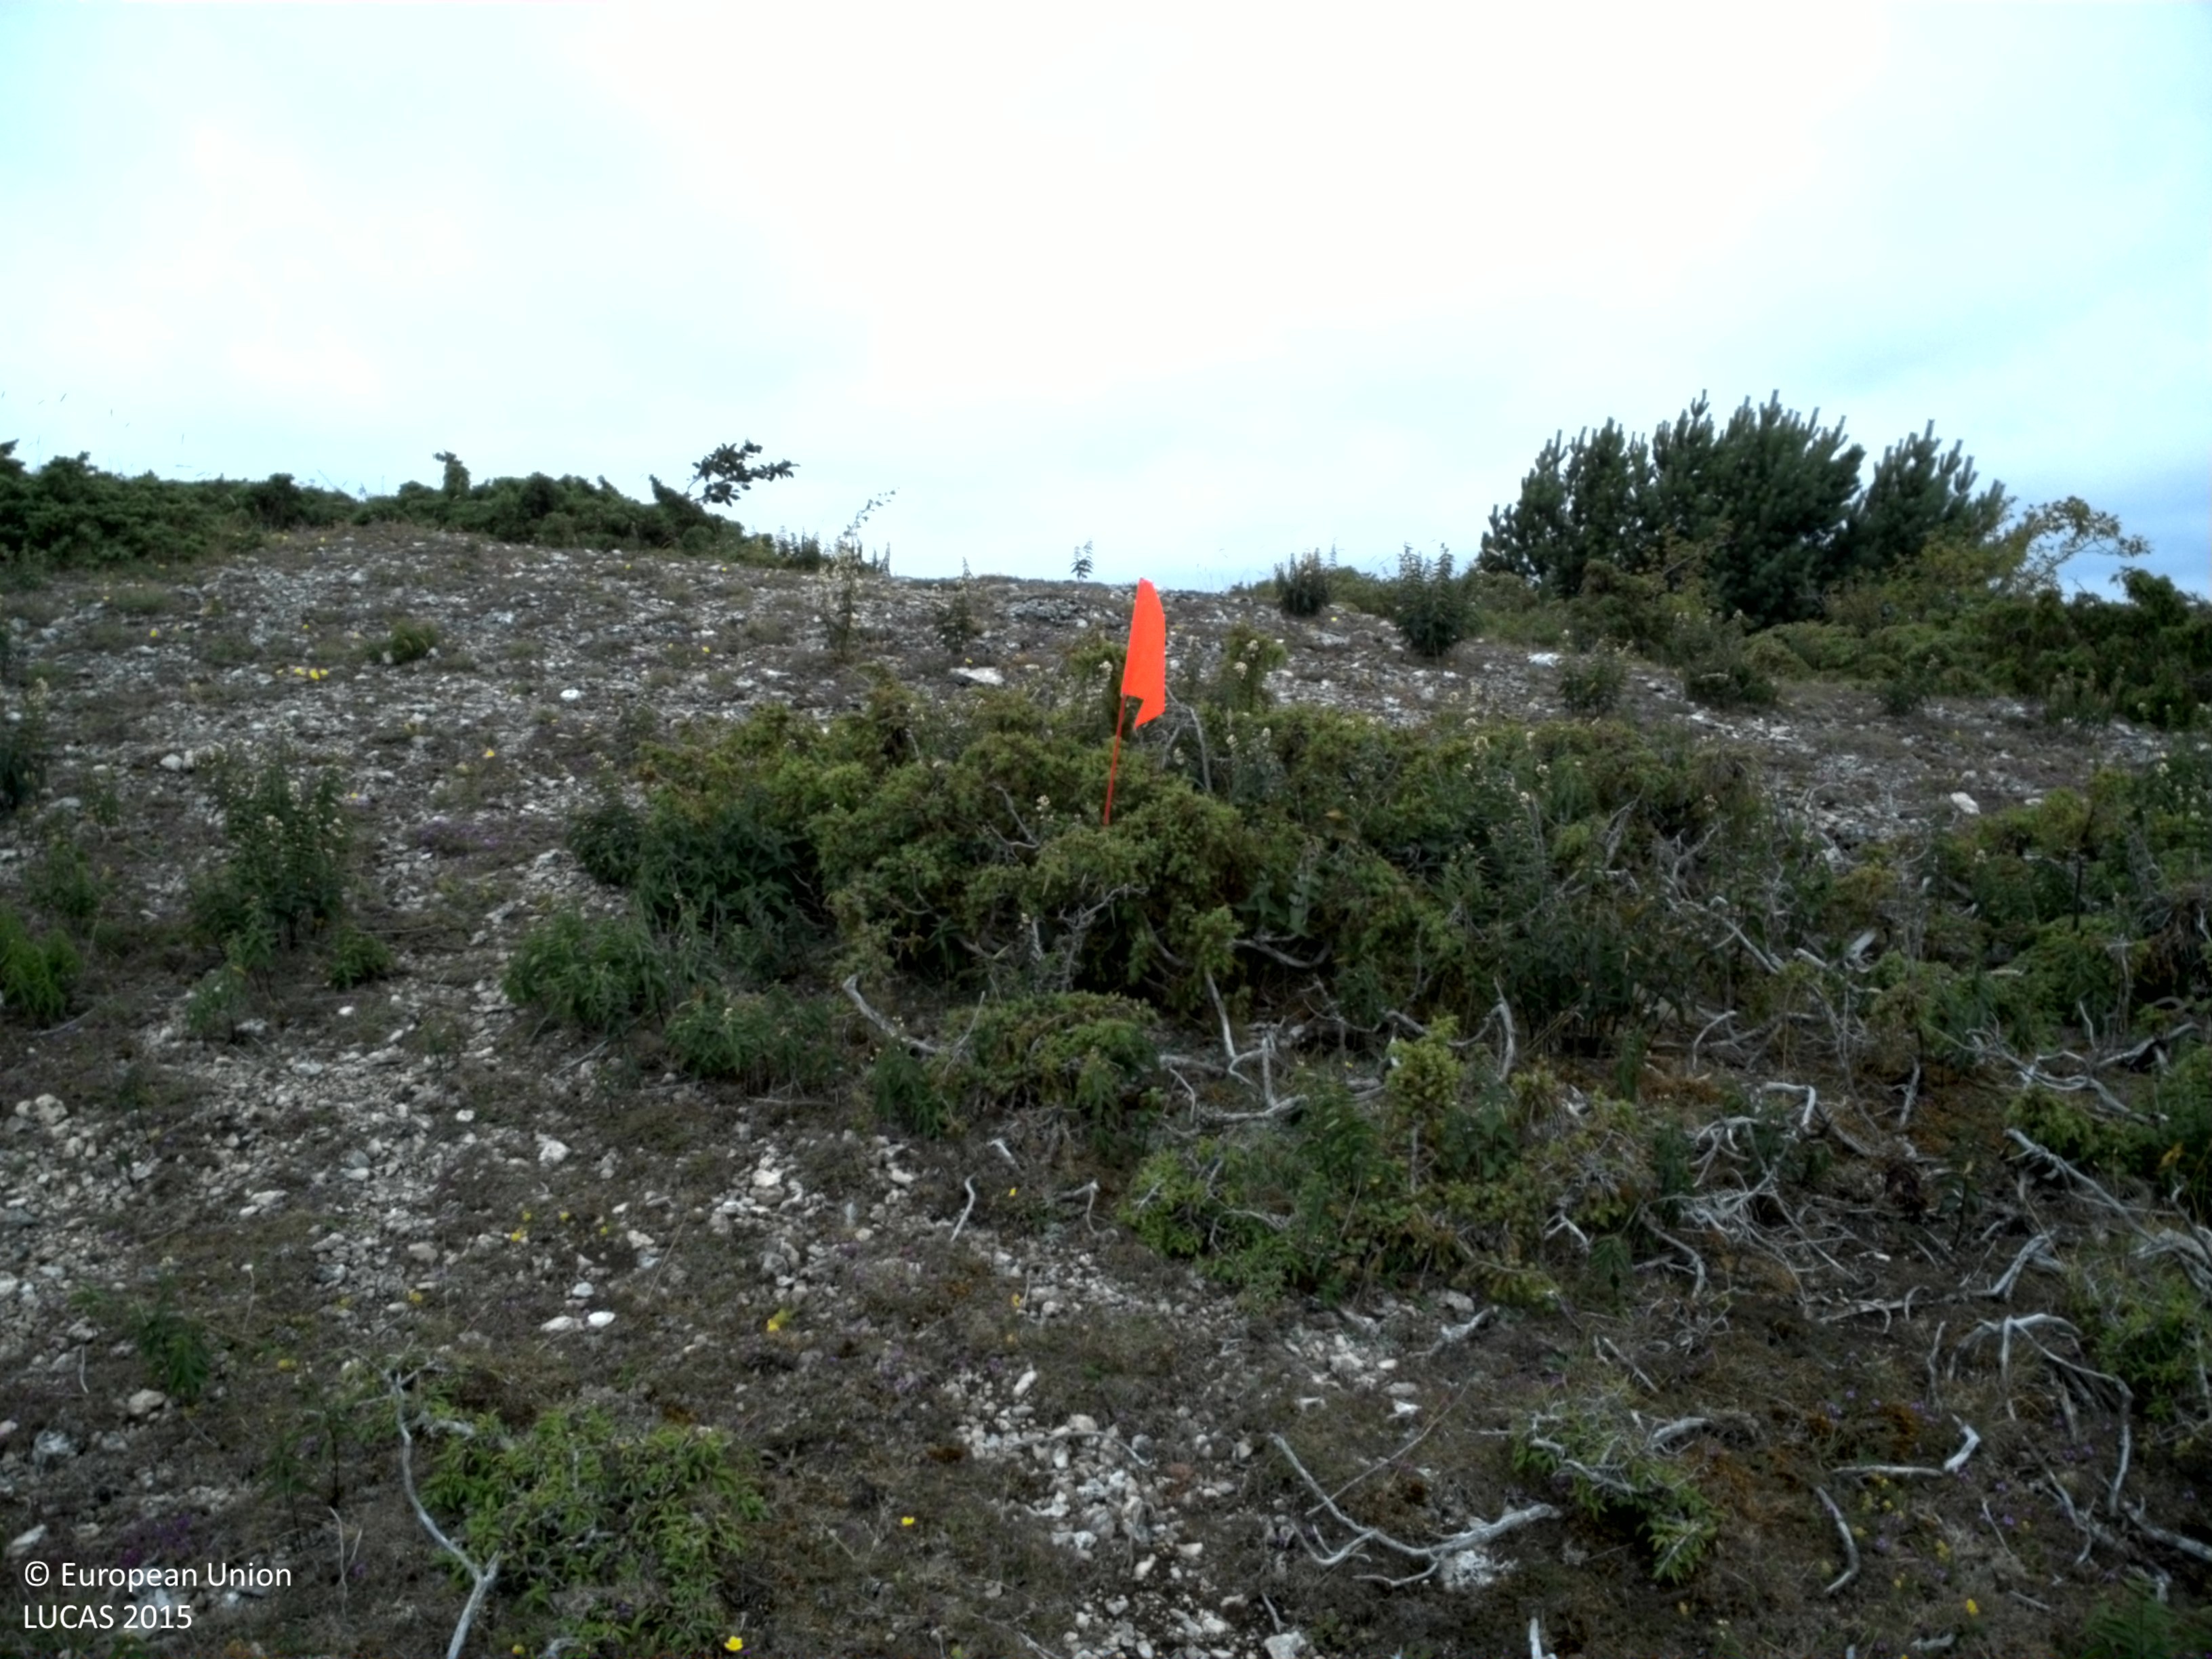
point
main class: Shrubland
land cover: Shrubland without tree cover
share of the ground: 50 - 75 %
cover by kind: shrubs 55 %, herbaceous plants 25 %, lichens and mosses 10 %, unconsolidated bare surface 10 %
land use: Agriculture (excluding fallow land and kitchen gardens)
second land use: Amenities, museums, leisure
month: July
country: SE
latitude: 56.9234
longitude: 18.1407
